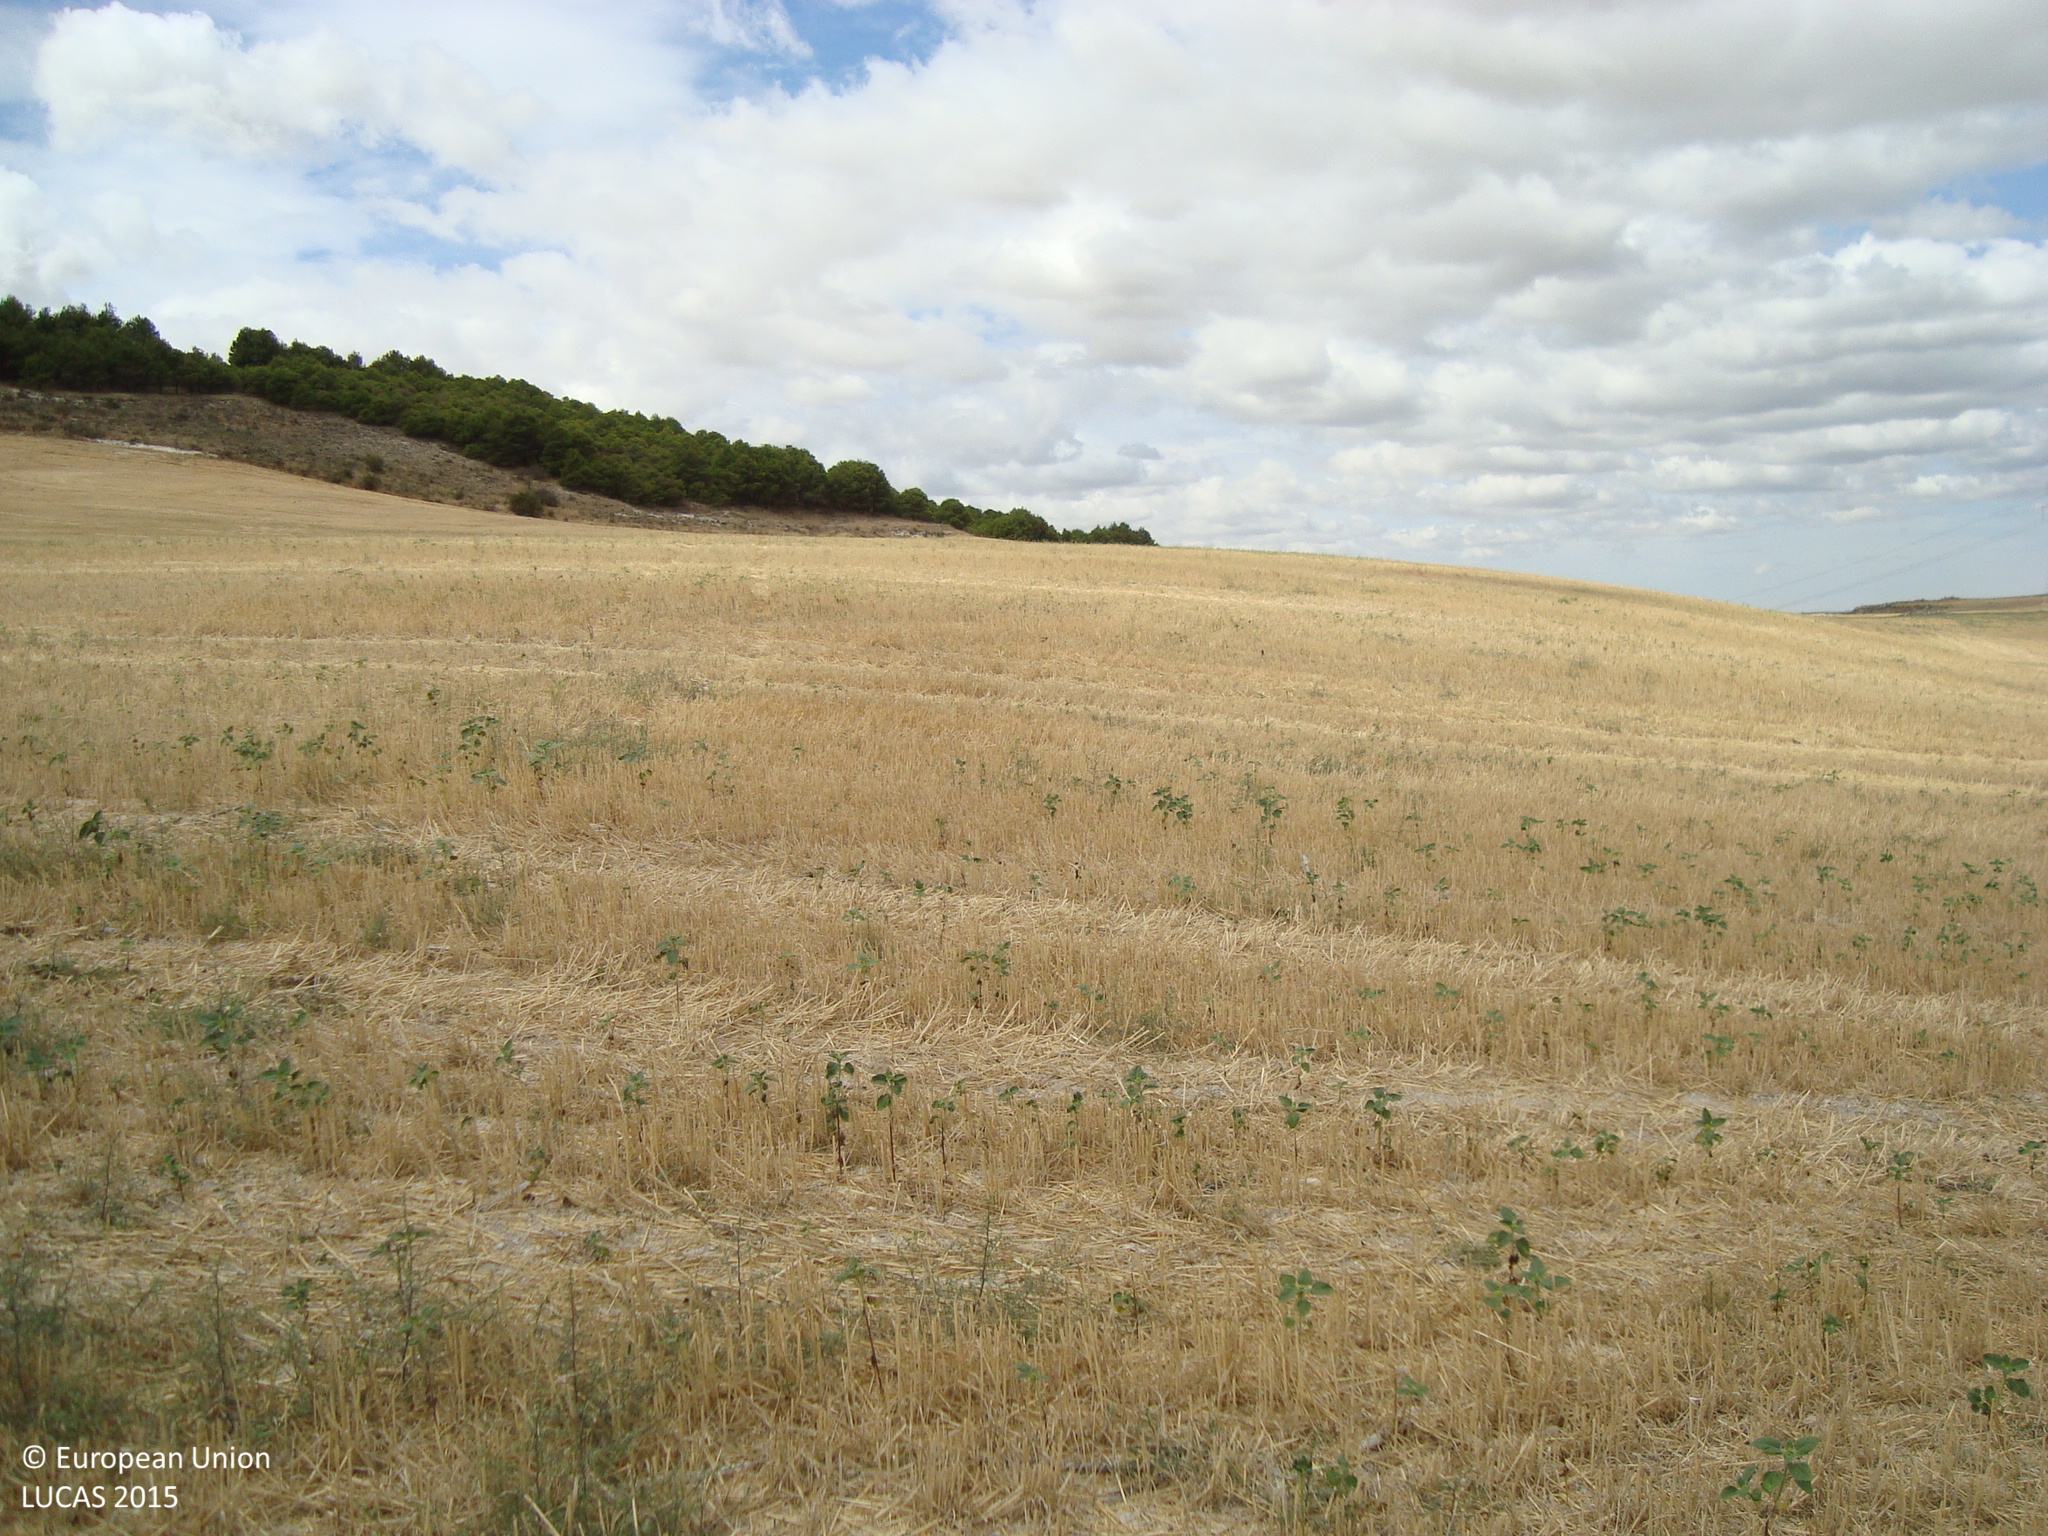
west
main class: Cropland
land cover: Common wheat
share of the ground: > 75 %
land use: Agriculture (excluding fallow land and kitchen gardens)
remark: Harvested field
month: August
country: ES
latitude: 42.0622
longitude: -4.1183
